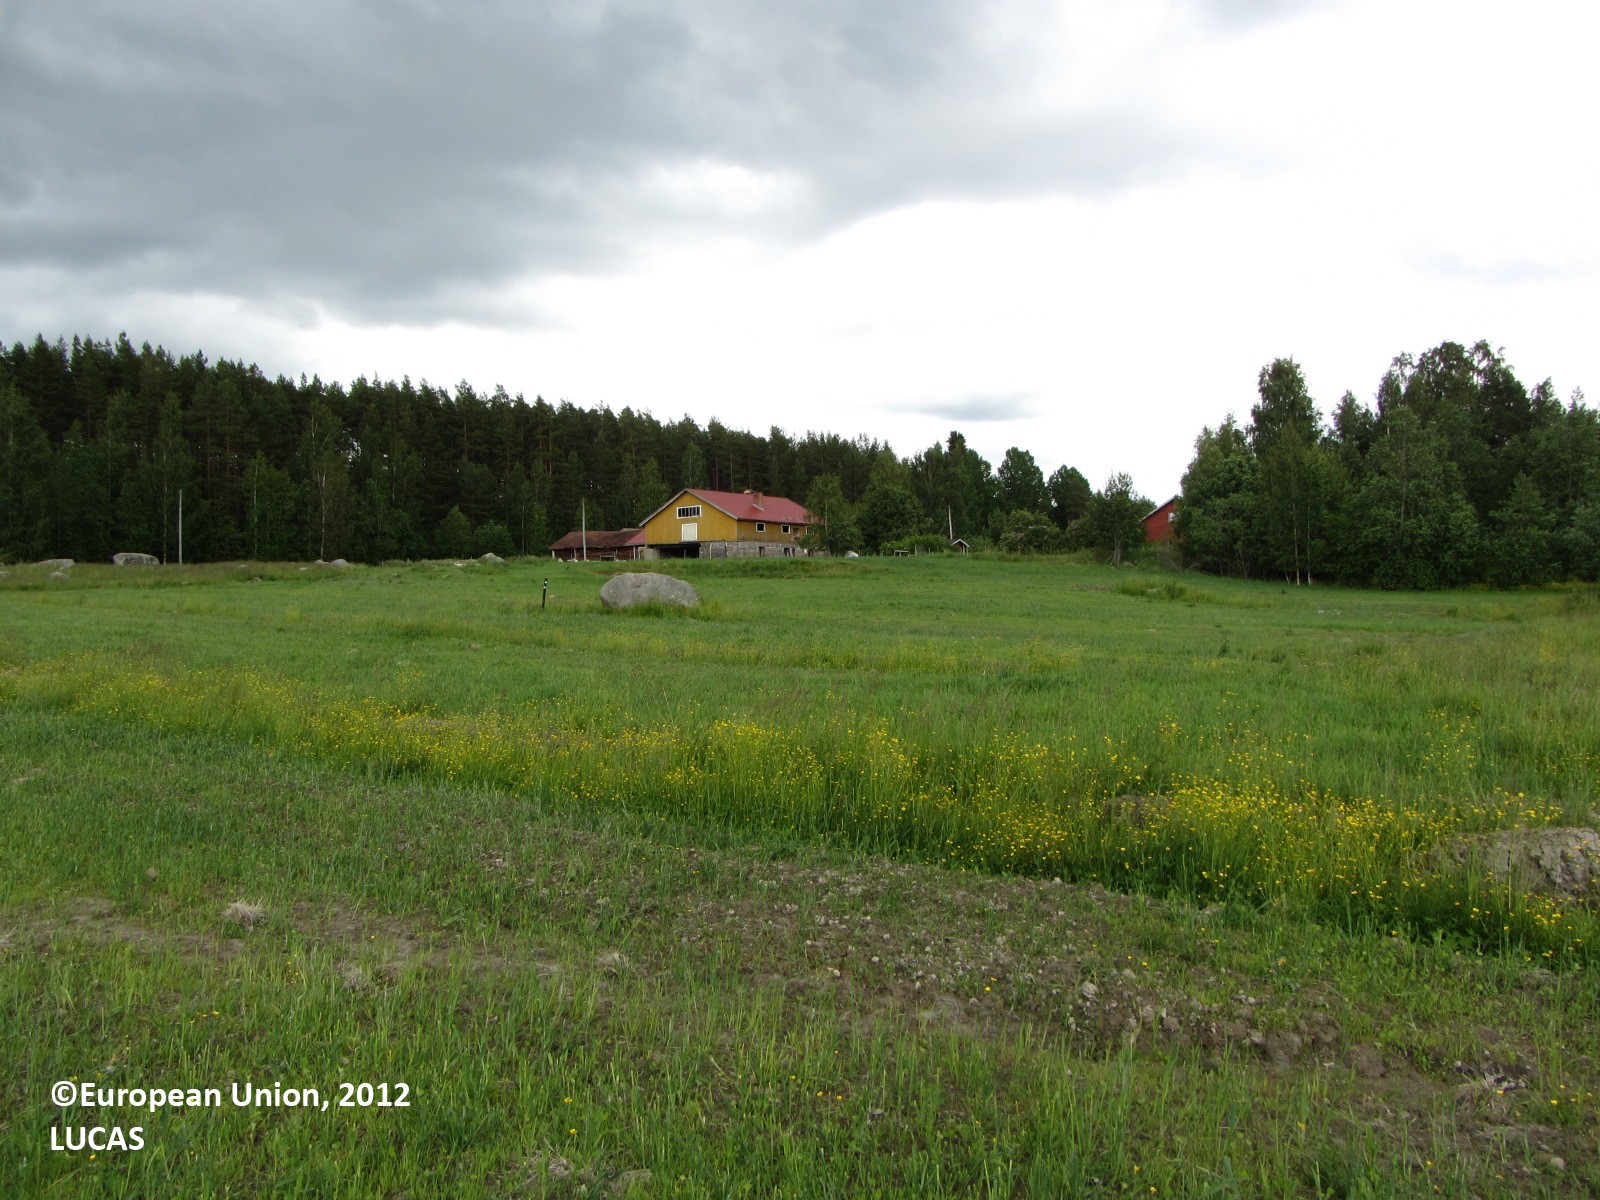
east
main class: Grassland
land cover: Grassland without tree/shrub cover
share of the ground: > 75 %
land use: Agriculture (excluding fallow land and kitchen gardens)
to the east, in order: Grassland without tree/shrub cover; Ditches and canals; Grassland without tree/shrub cover; Ditches and canals; Grassland without tree/shrub cover; Fences; Grassland without tree/shrub cover; Fences; Spontaneously vegetated surfaces; Paved roads, cycling and walking lanes; Grass margins; Ditches and canals; Broadleaved woodland; Rock outcrops; Broadleaved woodland; Pine dominated mixed woodland; Rock outcrops; Other coniferous woodland
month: June
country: FI
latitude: 62.7595
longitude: 25.5214
